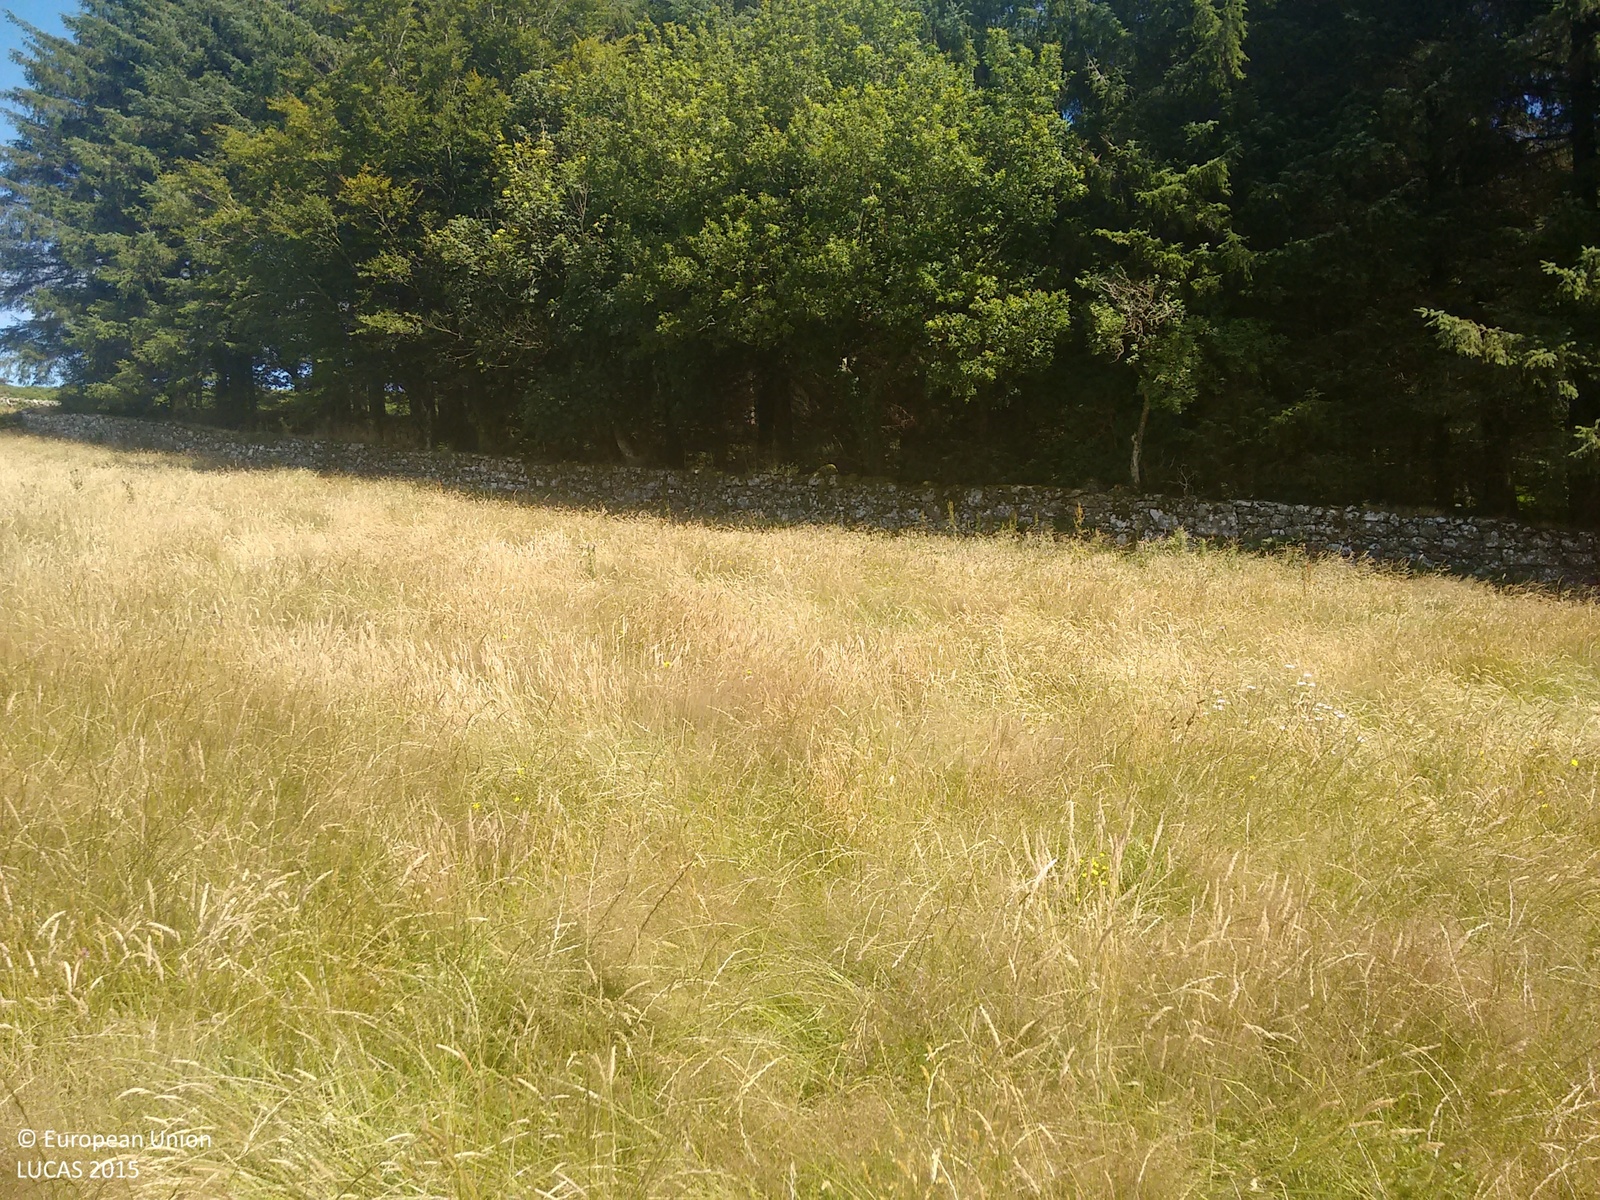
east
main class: Grassland
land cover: Grassland without tree/shrub cover
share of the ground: > 75 %
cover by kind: herbaceous plants 100 %
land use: Agriculture (excluding fallow land and kitchen gardens)
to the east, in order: Grassland without tree/shrub cover; Dry stone walls; Spruce dominated coniferous woodland; Dry stone walls; Spruce dominated coniferous woodland; Grassland without tree/shrub cover; Shrubland with sparse tree cover
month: July
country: GB
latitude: 50.5453
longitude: -3.7921
